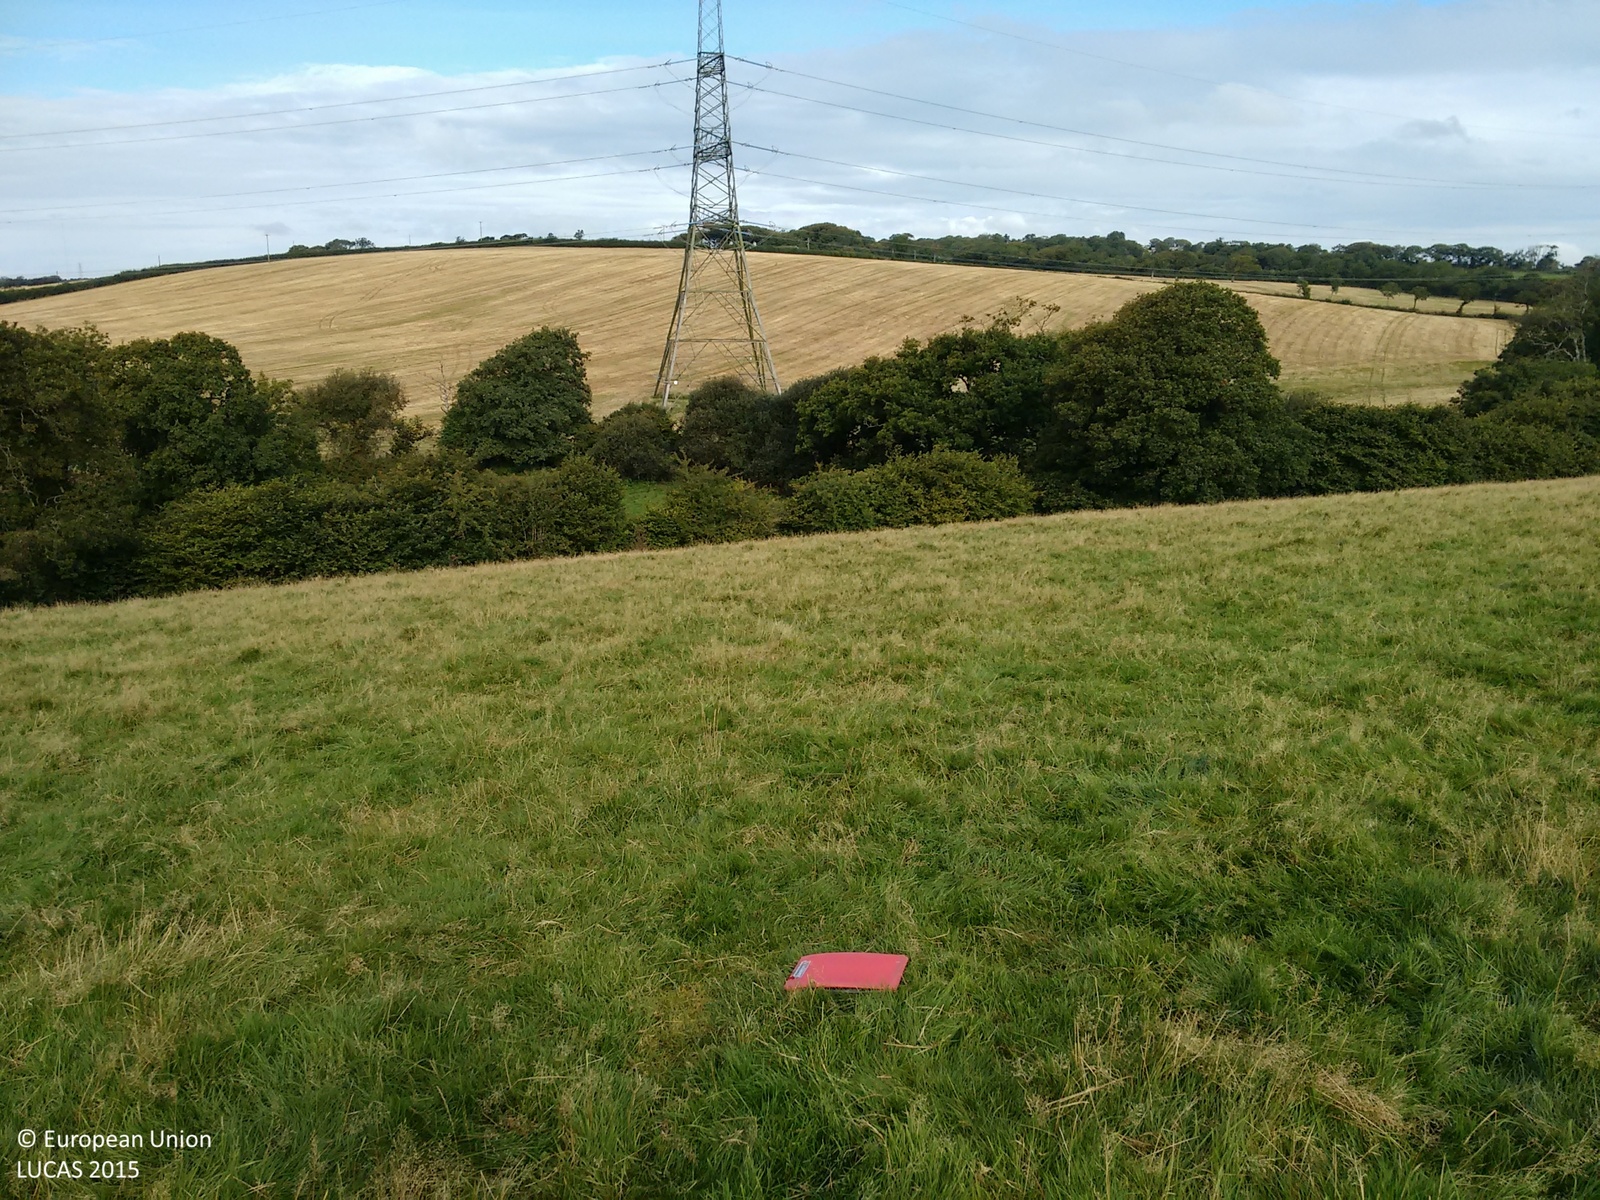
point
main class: Grassland
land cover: Grassland without tree/shrub cover
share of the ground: > 75 %
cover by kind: herbaceous plants 100 %
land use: Agriculture (excluding fallow land and kitchen gardens)
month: September
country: GB
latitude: 50.7155
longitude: -4.4798
